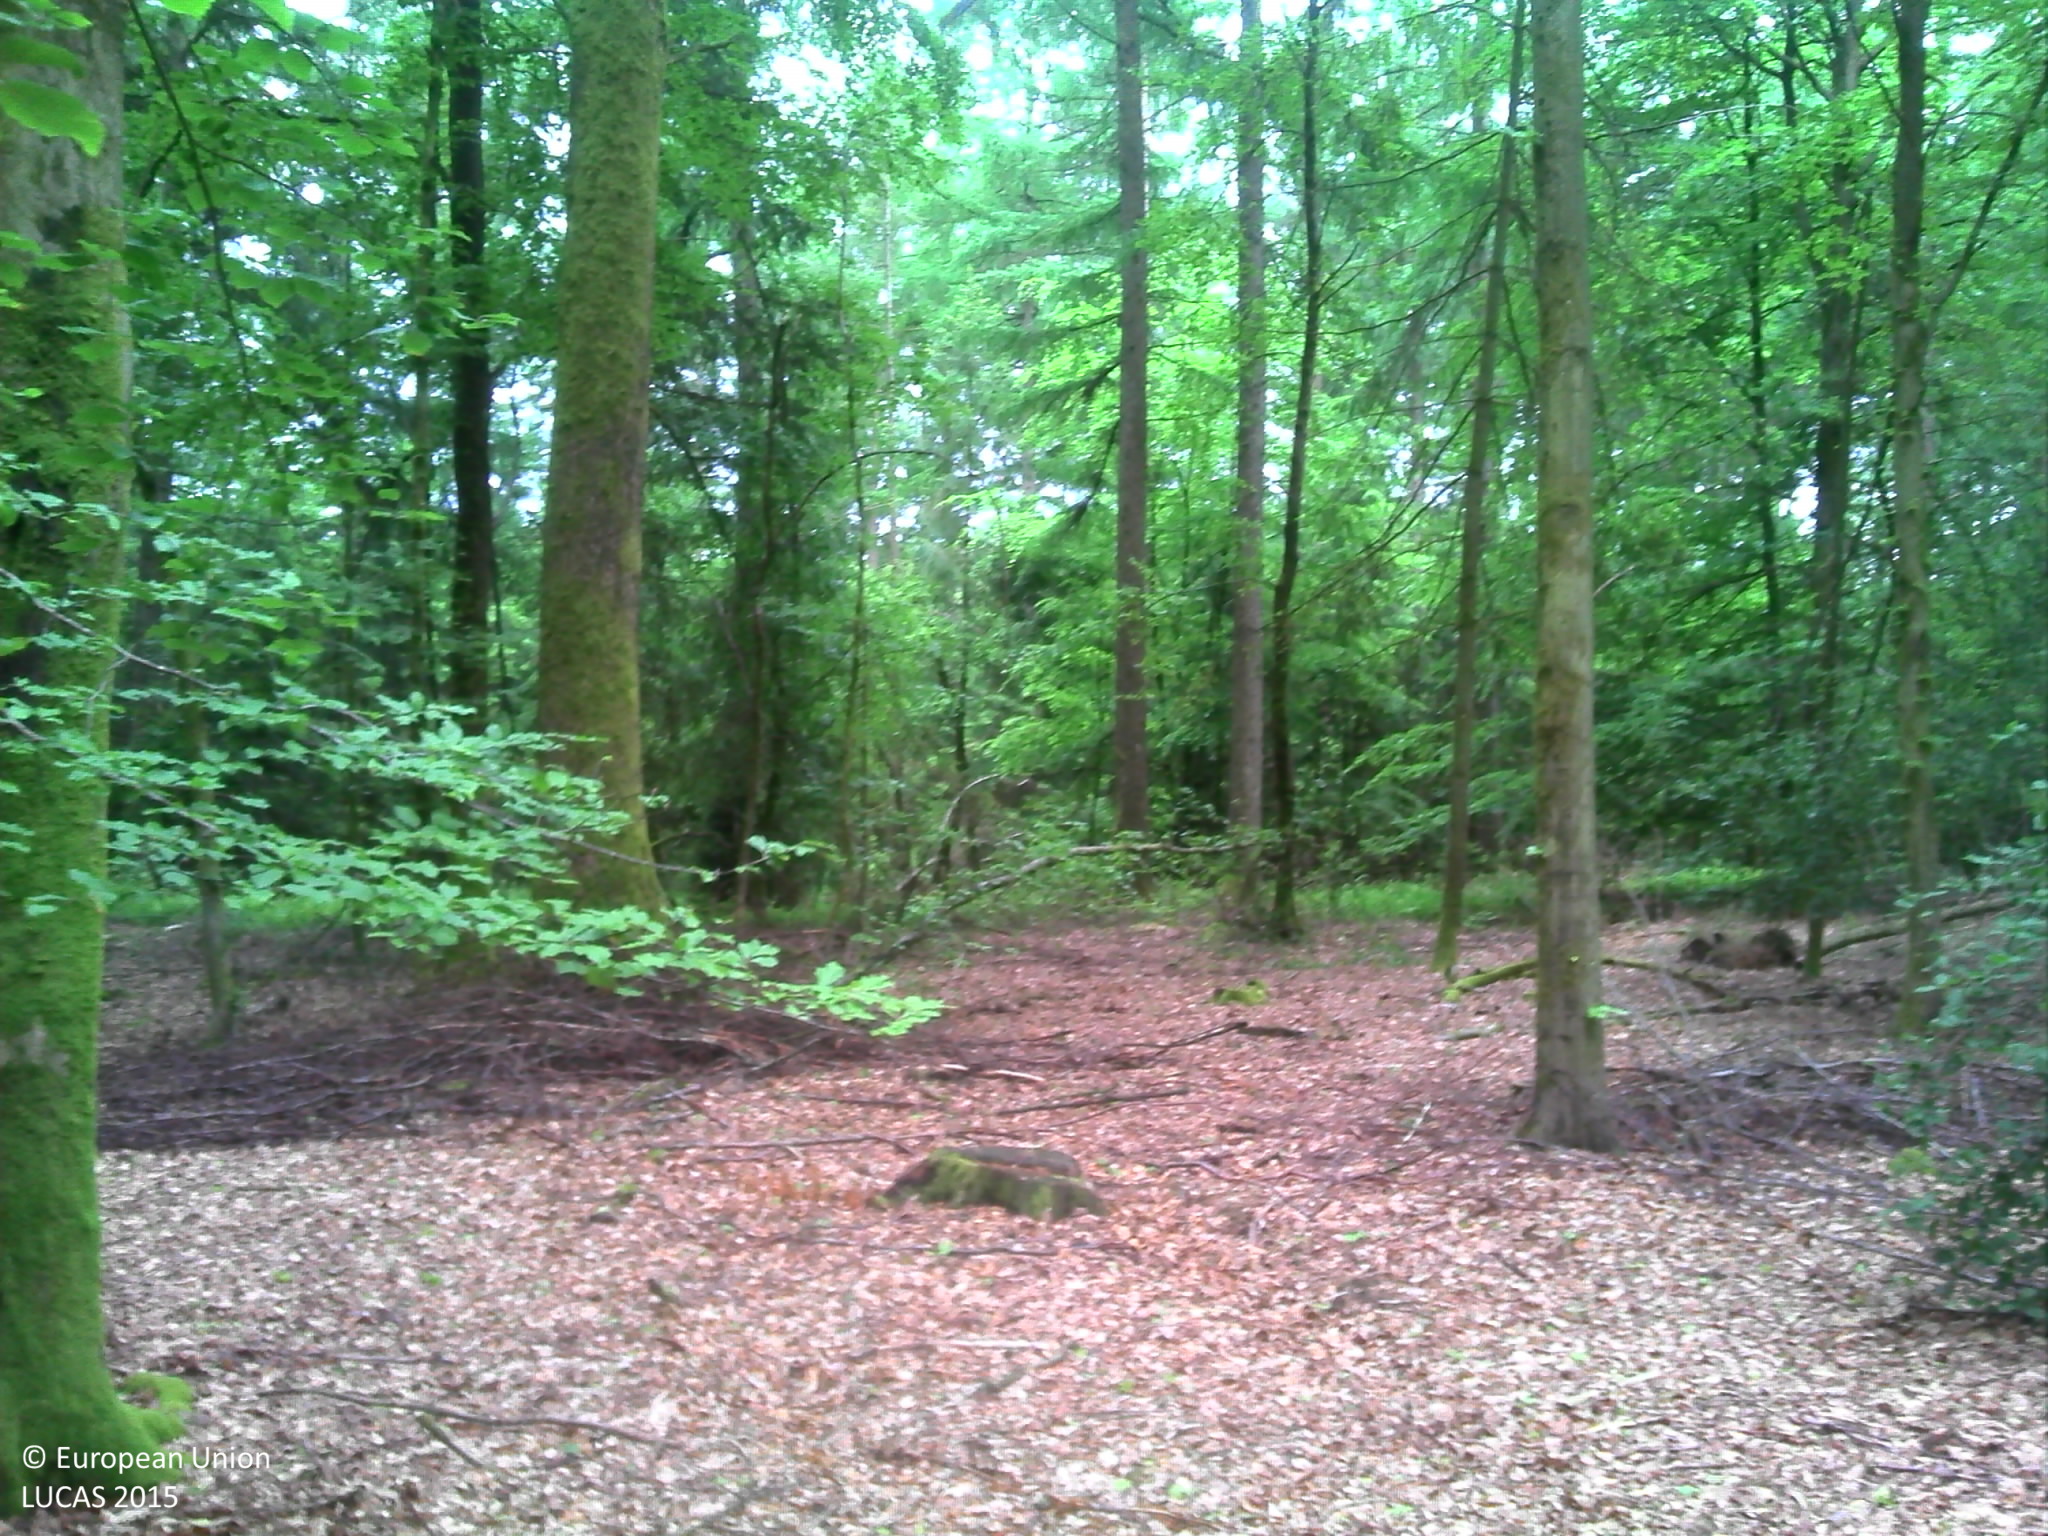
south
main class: Woodland
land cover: Broadleaved woodland
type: acidophilous oak and oak-birch forest
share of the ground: > 75 %
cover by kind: broadleaved forest trees 95 %, unconsolidated bare surface 5 %
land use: Forestry
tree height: > 5 m
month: June
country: BE
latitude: 49.9253
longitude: 4.8849
